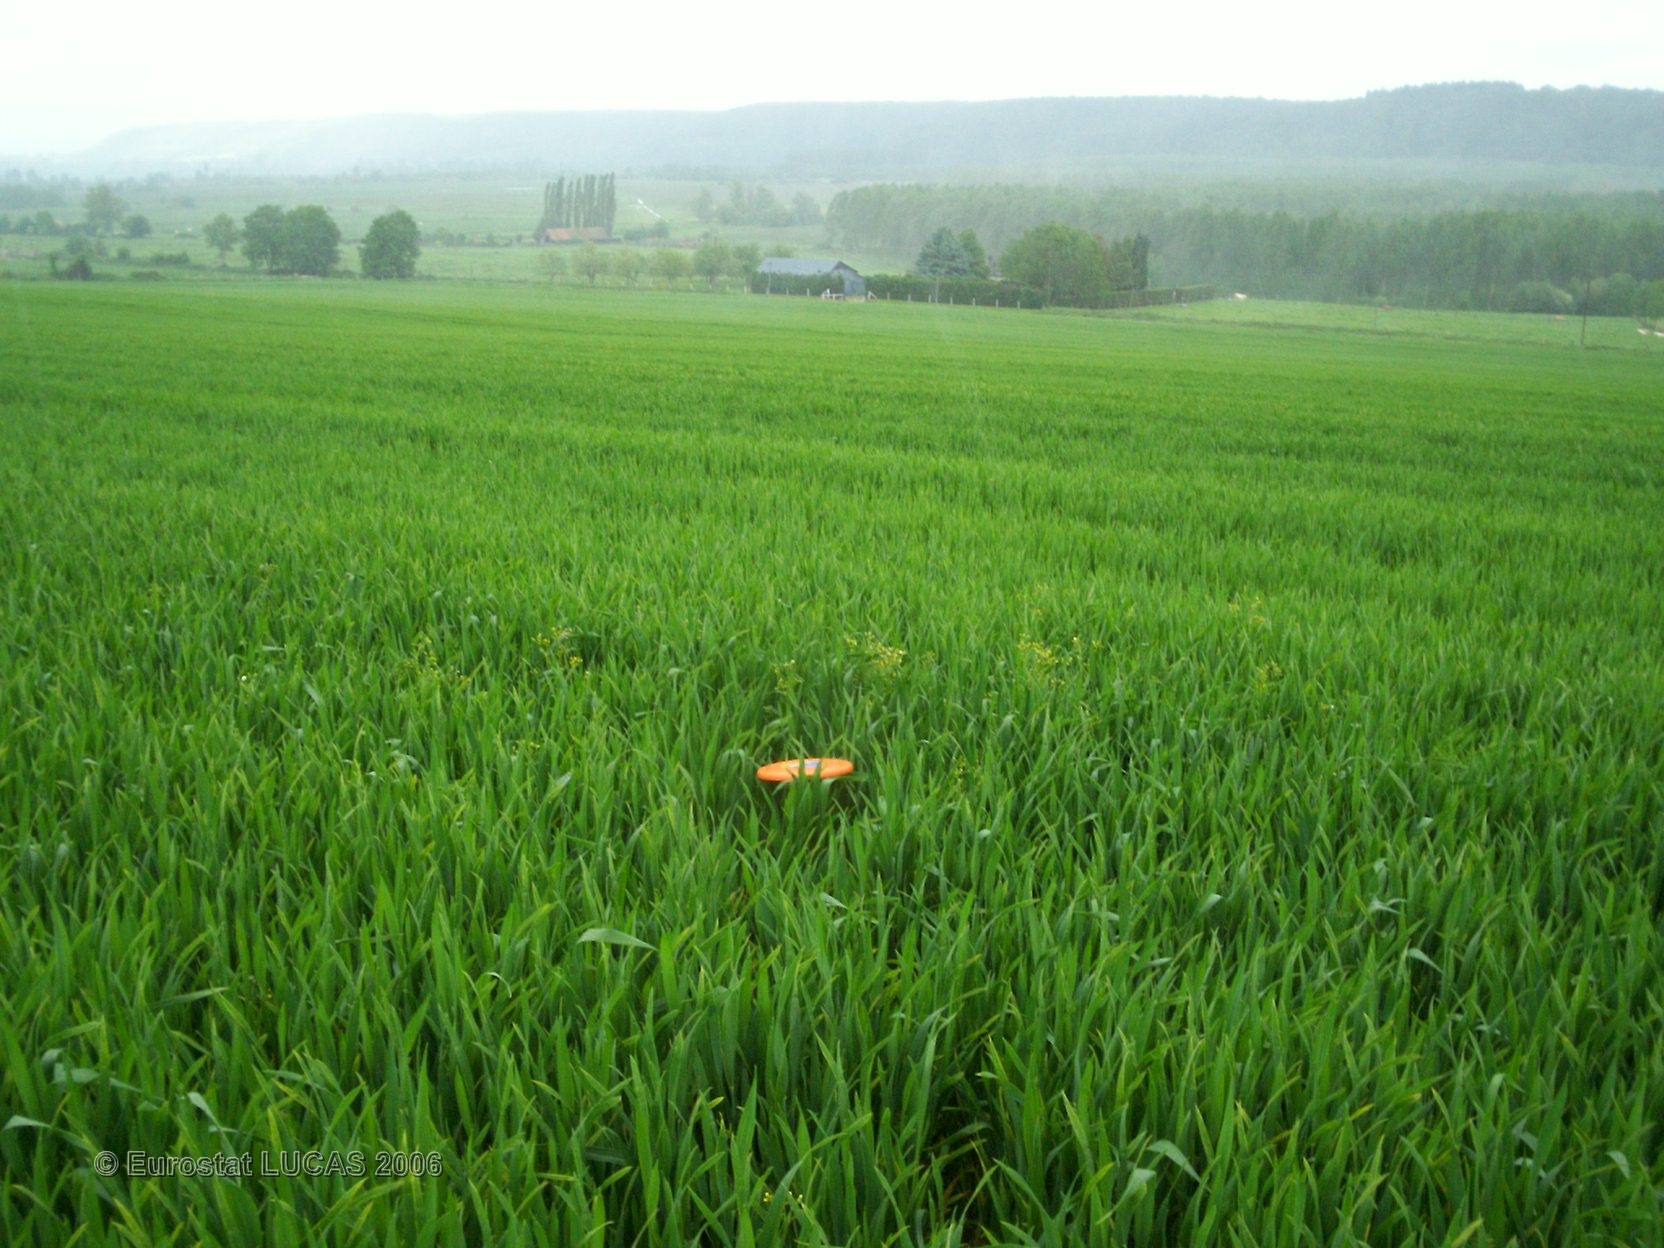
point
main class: Cropland
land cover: Common wheat
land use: Agriculture (excluding fallow land and kitchen gardens)
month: May
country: FR
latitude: 49.3666
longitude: 0.4577
